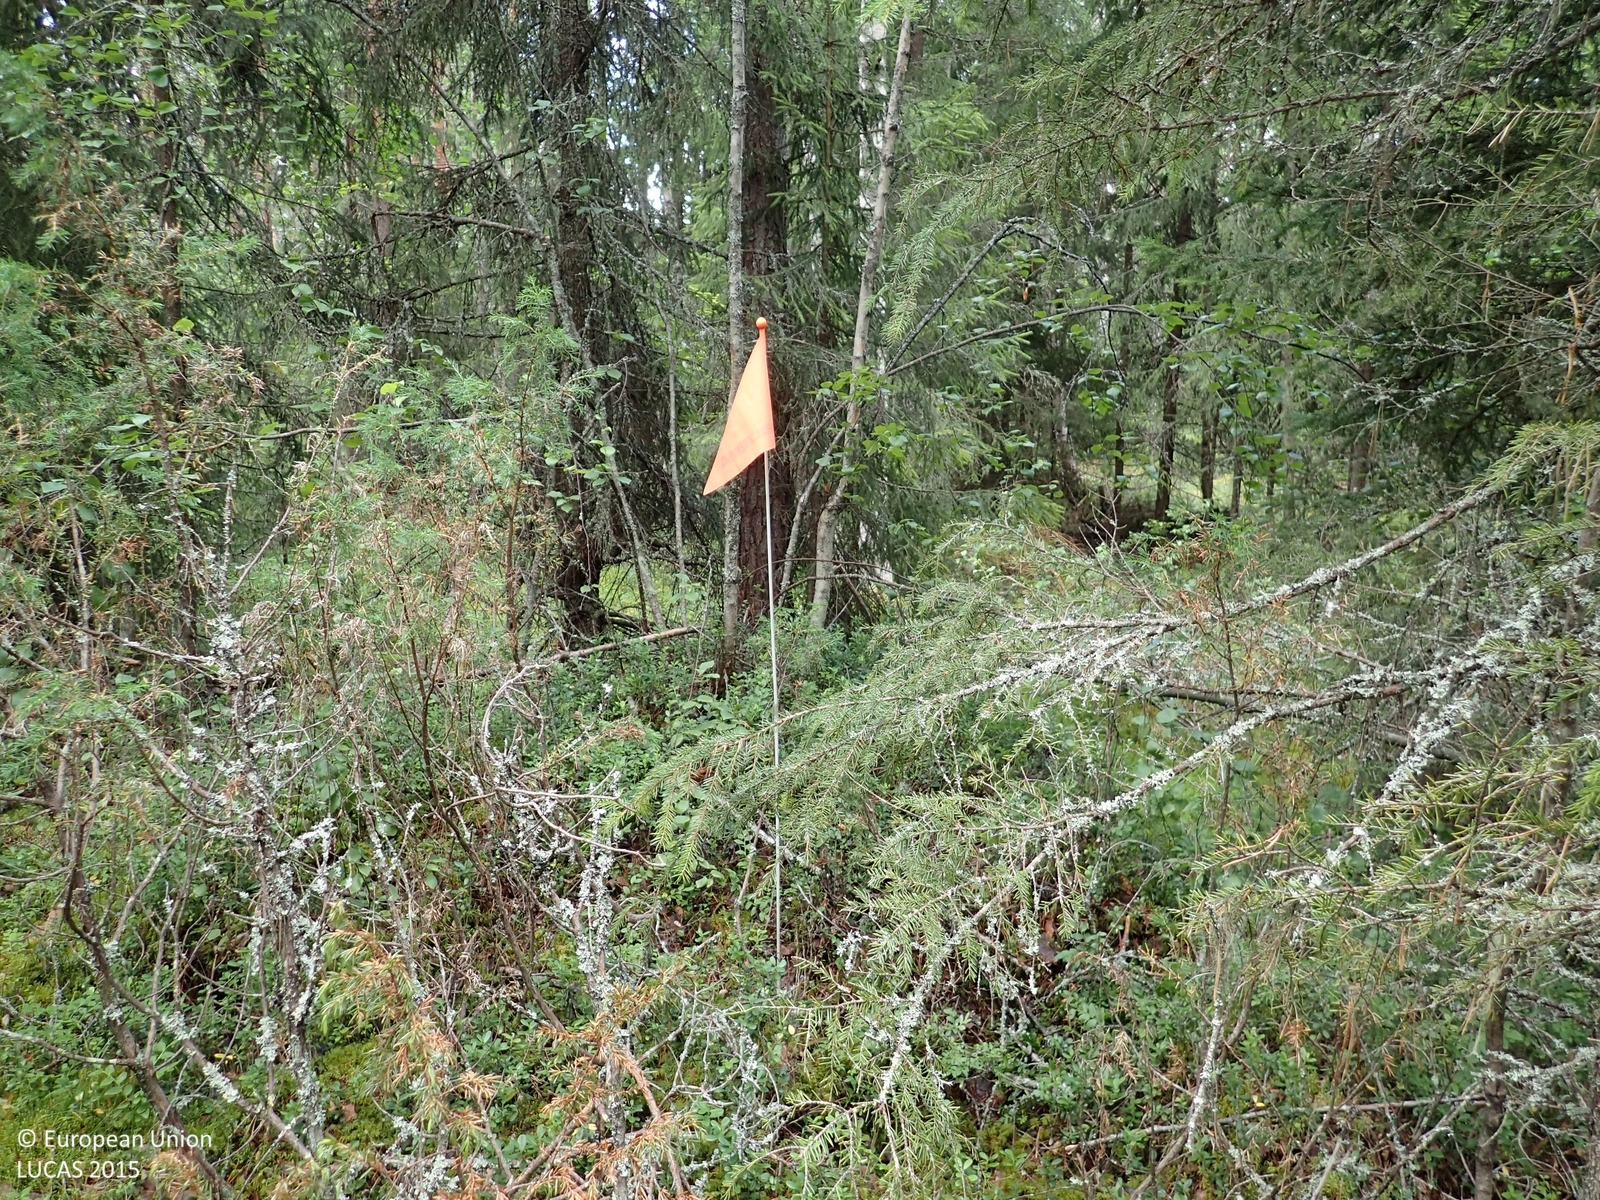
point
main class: Woodland
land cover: Pine dominated mixed woodland
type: boreal forest
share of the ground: > 75 %
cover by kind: coniferous forest trees 60 %, broadleaved forest trees 20 %, shrubs 15 %, lichens and mosses 5 %
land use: Forestry
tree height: > 5 m
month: August
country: FI
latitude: 62.6926
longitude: 21.8274
